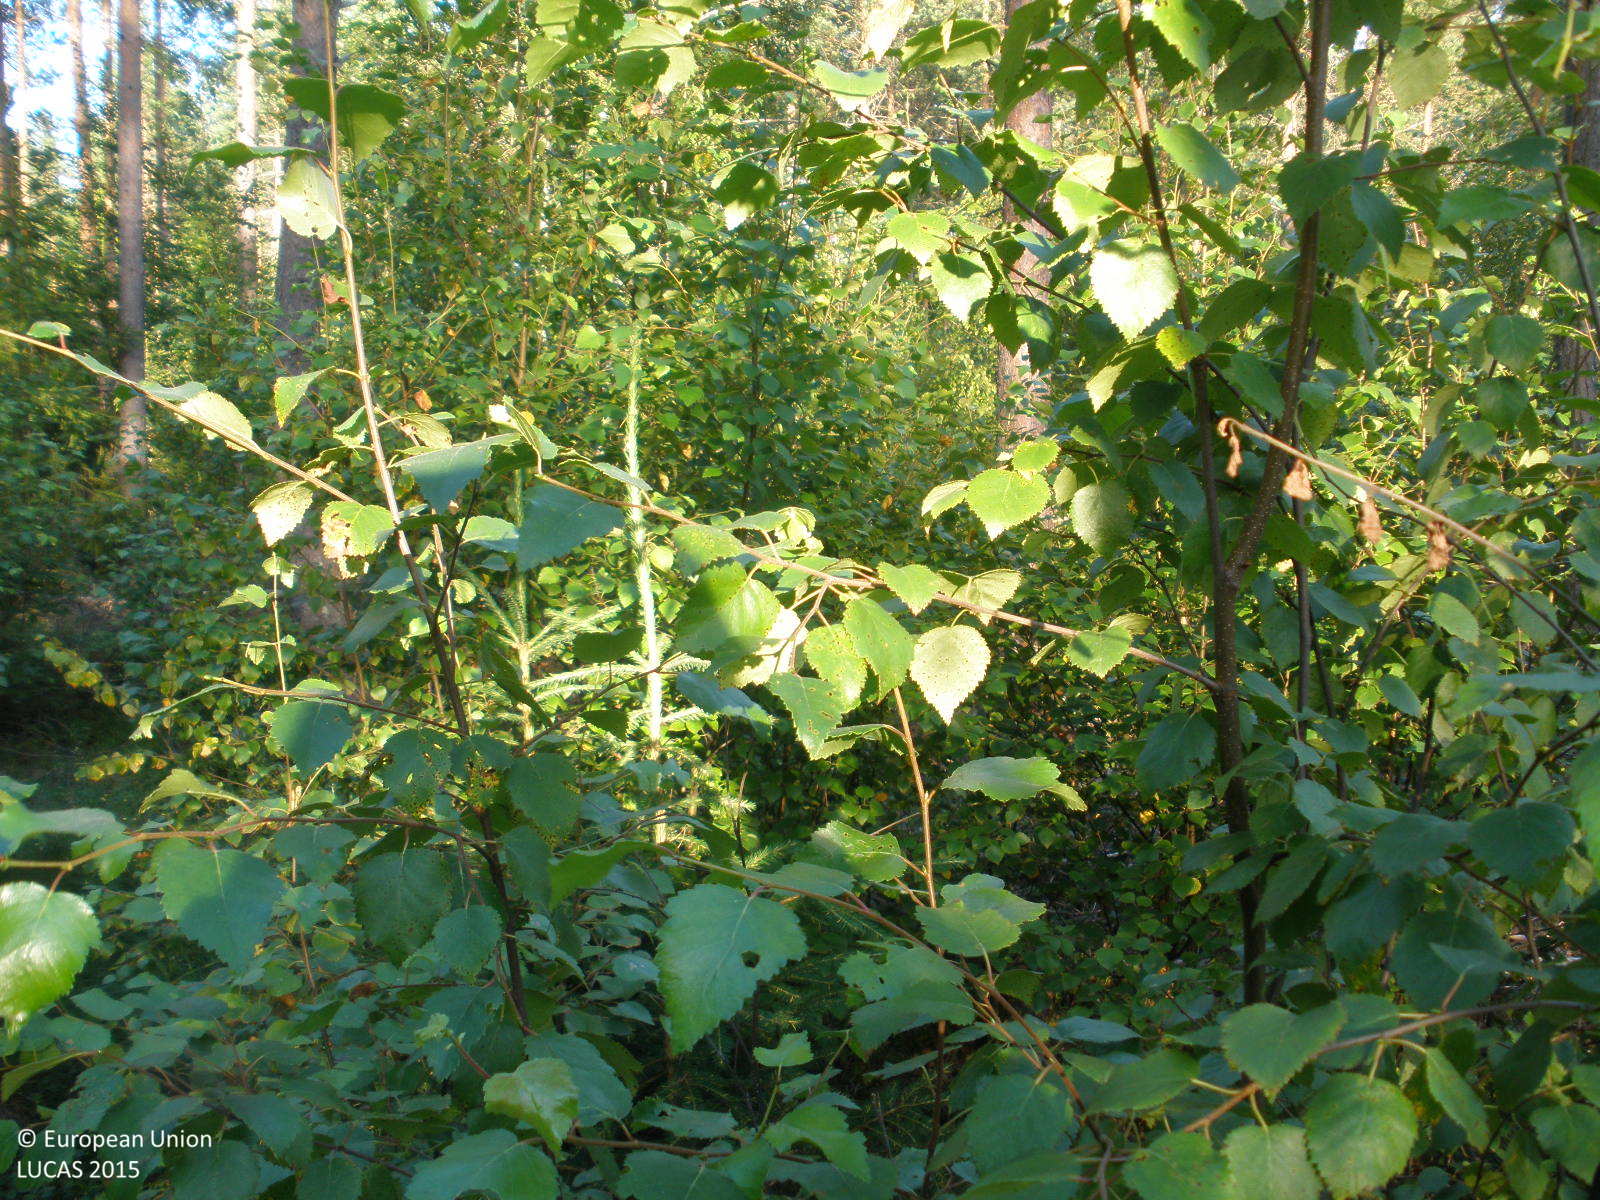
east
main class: Woodland
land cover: Pine dominated coniferous woodland
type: boreal forest
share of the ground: > 75 %
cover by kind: coniferous forest trees 70 %, broadleaved forest trees 15 %, shrubs 5 %, herbaceous plants 5 %, lichens and mosses 5 %
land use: Forestry
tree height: > 5 m
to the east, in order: Pine dominated coniferous woodland; Broadleaved woodland; Pine dominated coniferous woodland; Ditches and canals; Other mixed woodland; Spruce dominated mixed woodland; Other mixed woodland; Spruce dominated mixed woodland; Other mixed woodland; Spruce dominated mixed woodland
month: August
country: FI
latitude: 60.9877
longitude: 24.8416
